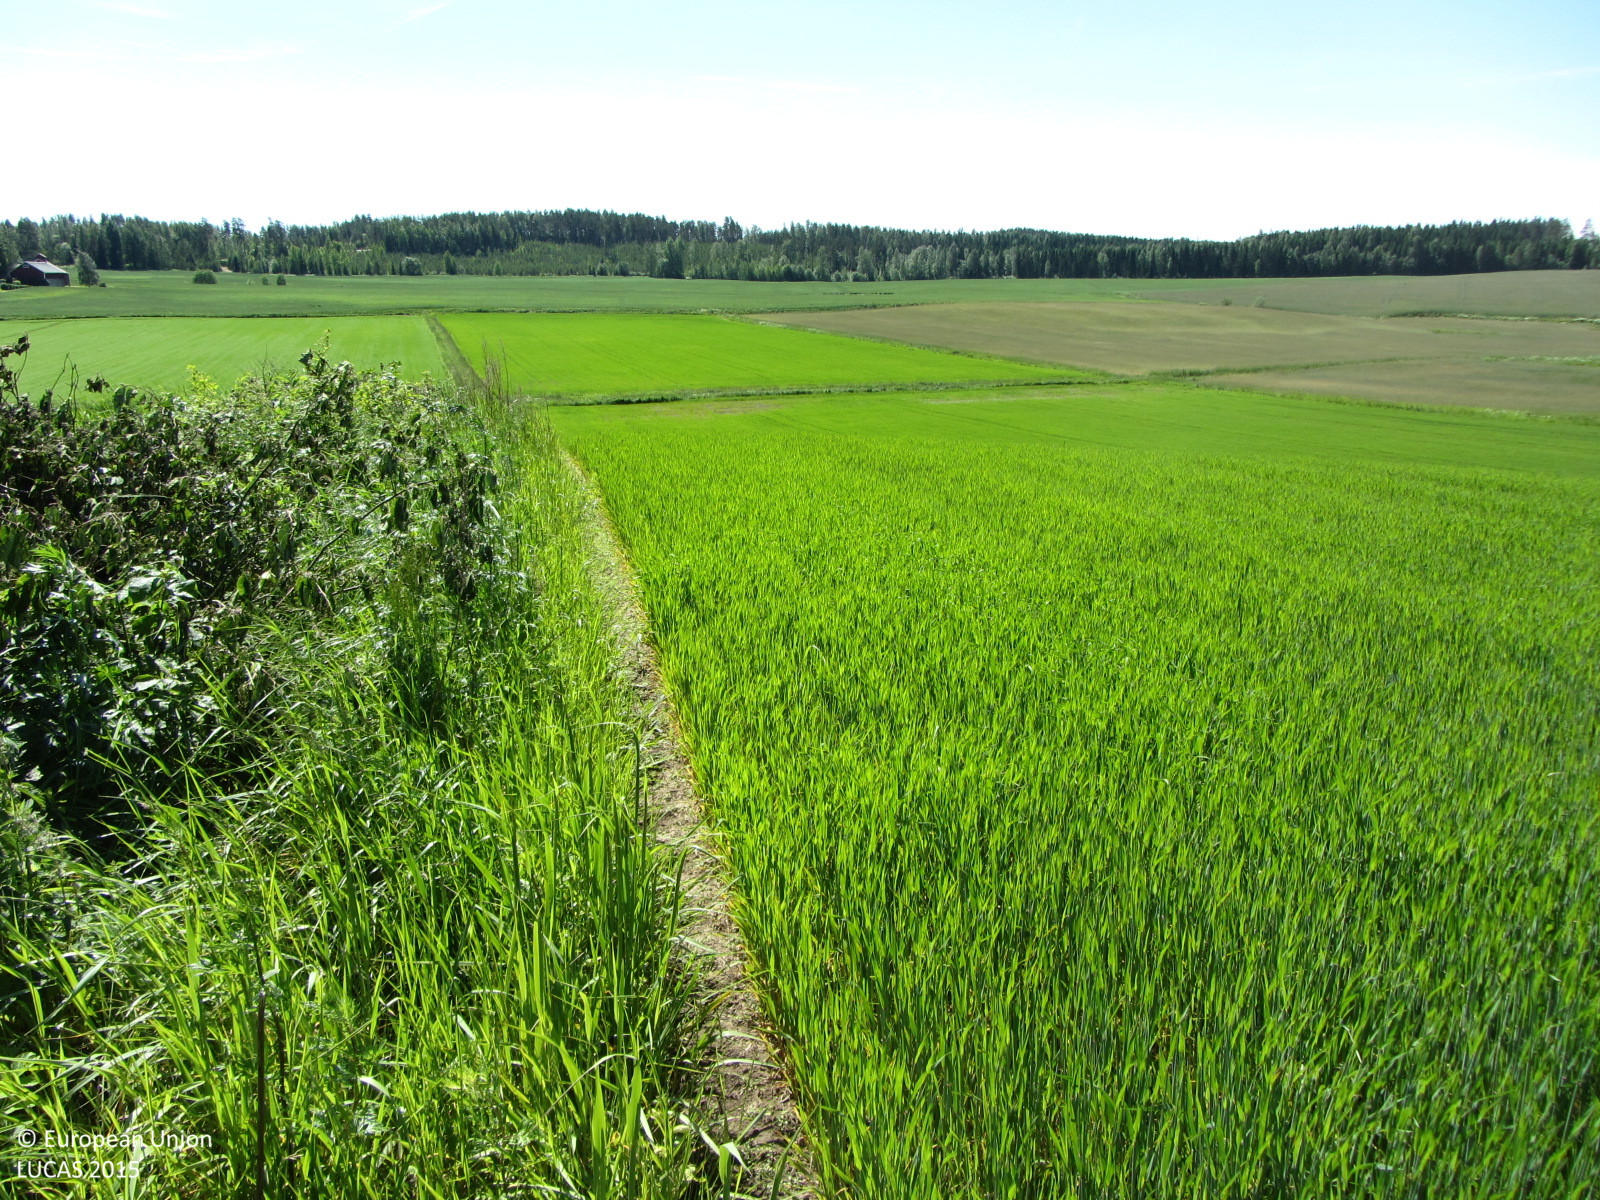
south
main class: Cropland
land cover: Barley
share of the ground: > 75 %
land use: Agriculture (excluding fallow land and kitchen gardens)
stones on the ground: < 10 %
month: June
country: FI
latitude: 60.3173
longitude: 23.2817
